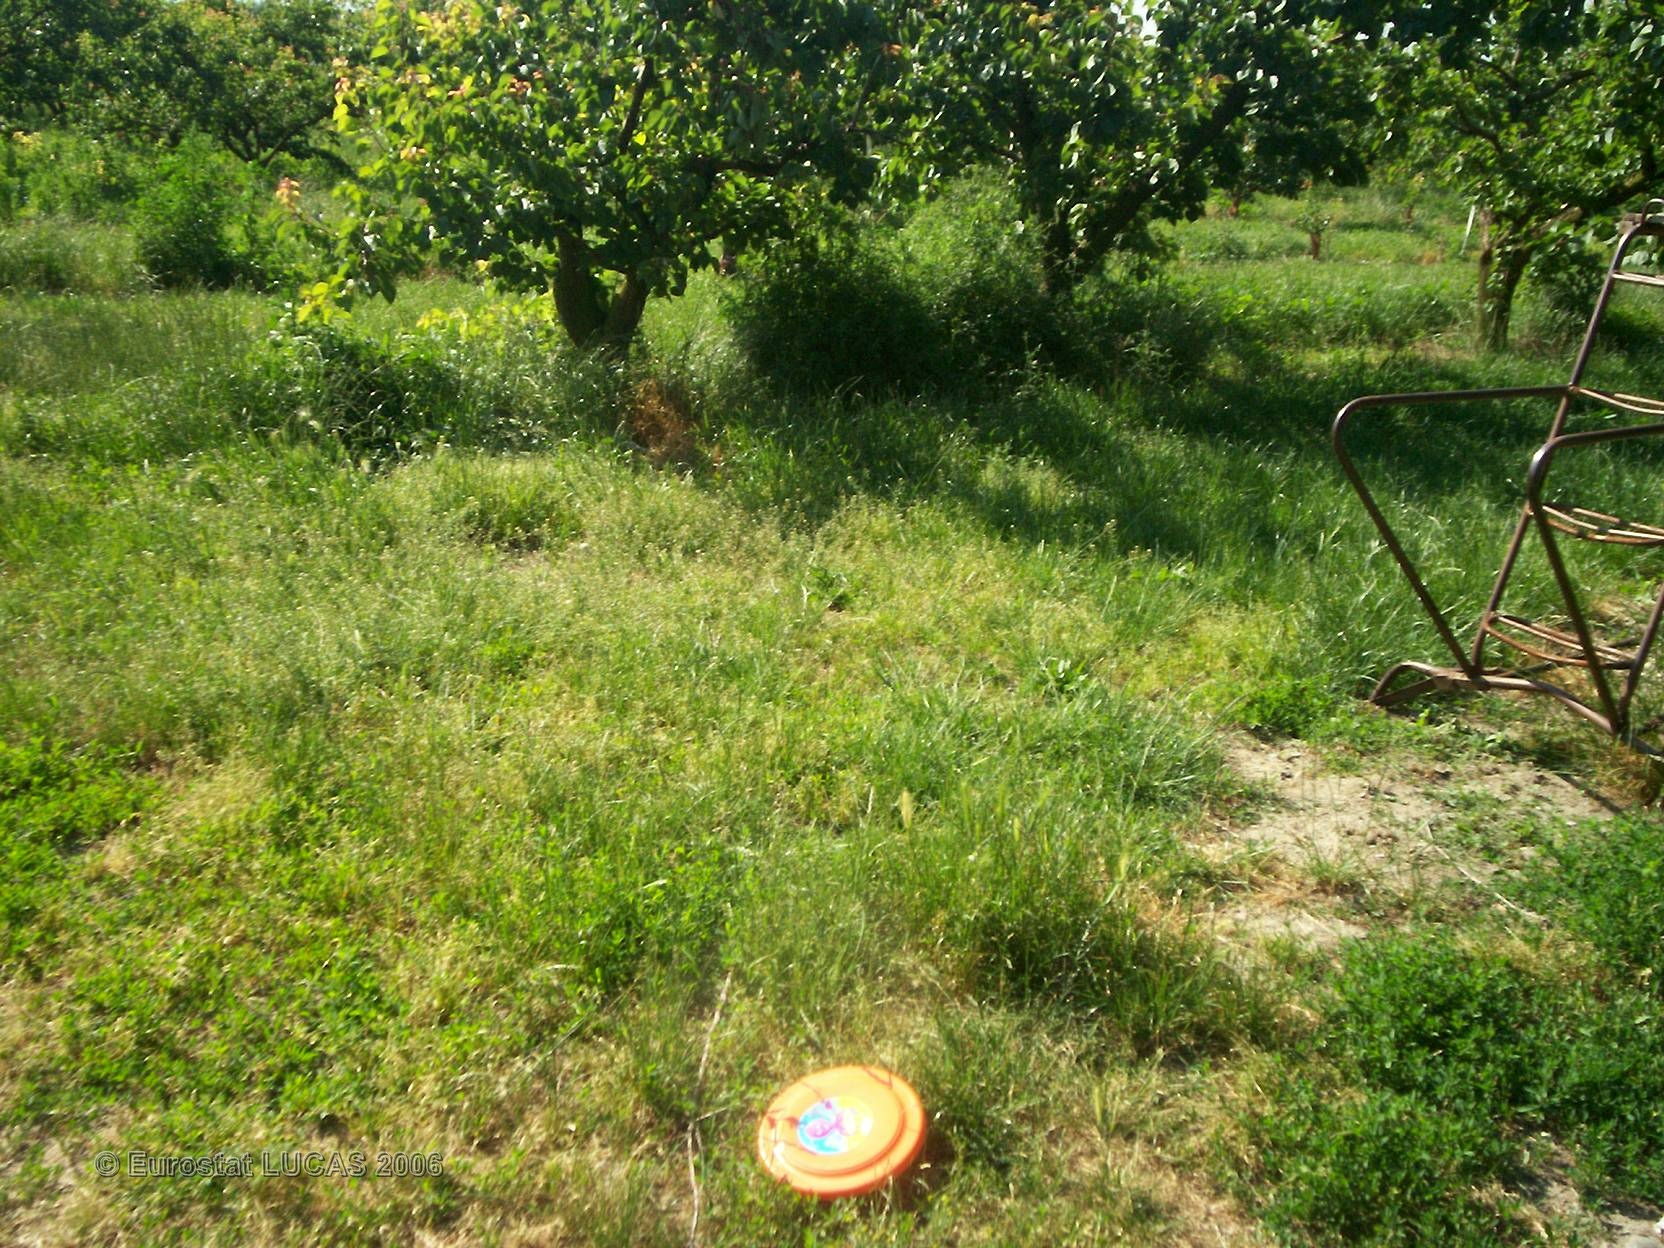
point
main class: Cropland
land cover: Other fruit trees and berries
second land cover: Grassland with sparse tree/shrub cover
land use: Agriculture (excluding fallow land and kitchen gardens)
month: June
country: FR
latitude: 45.0723
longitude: 4.8611
